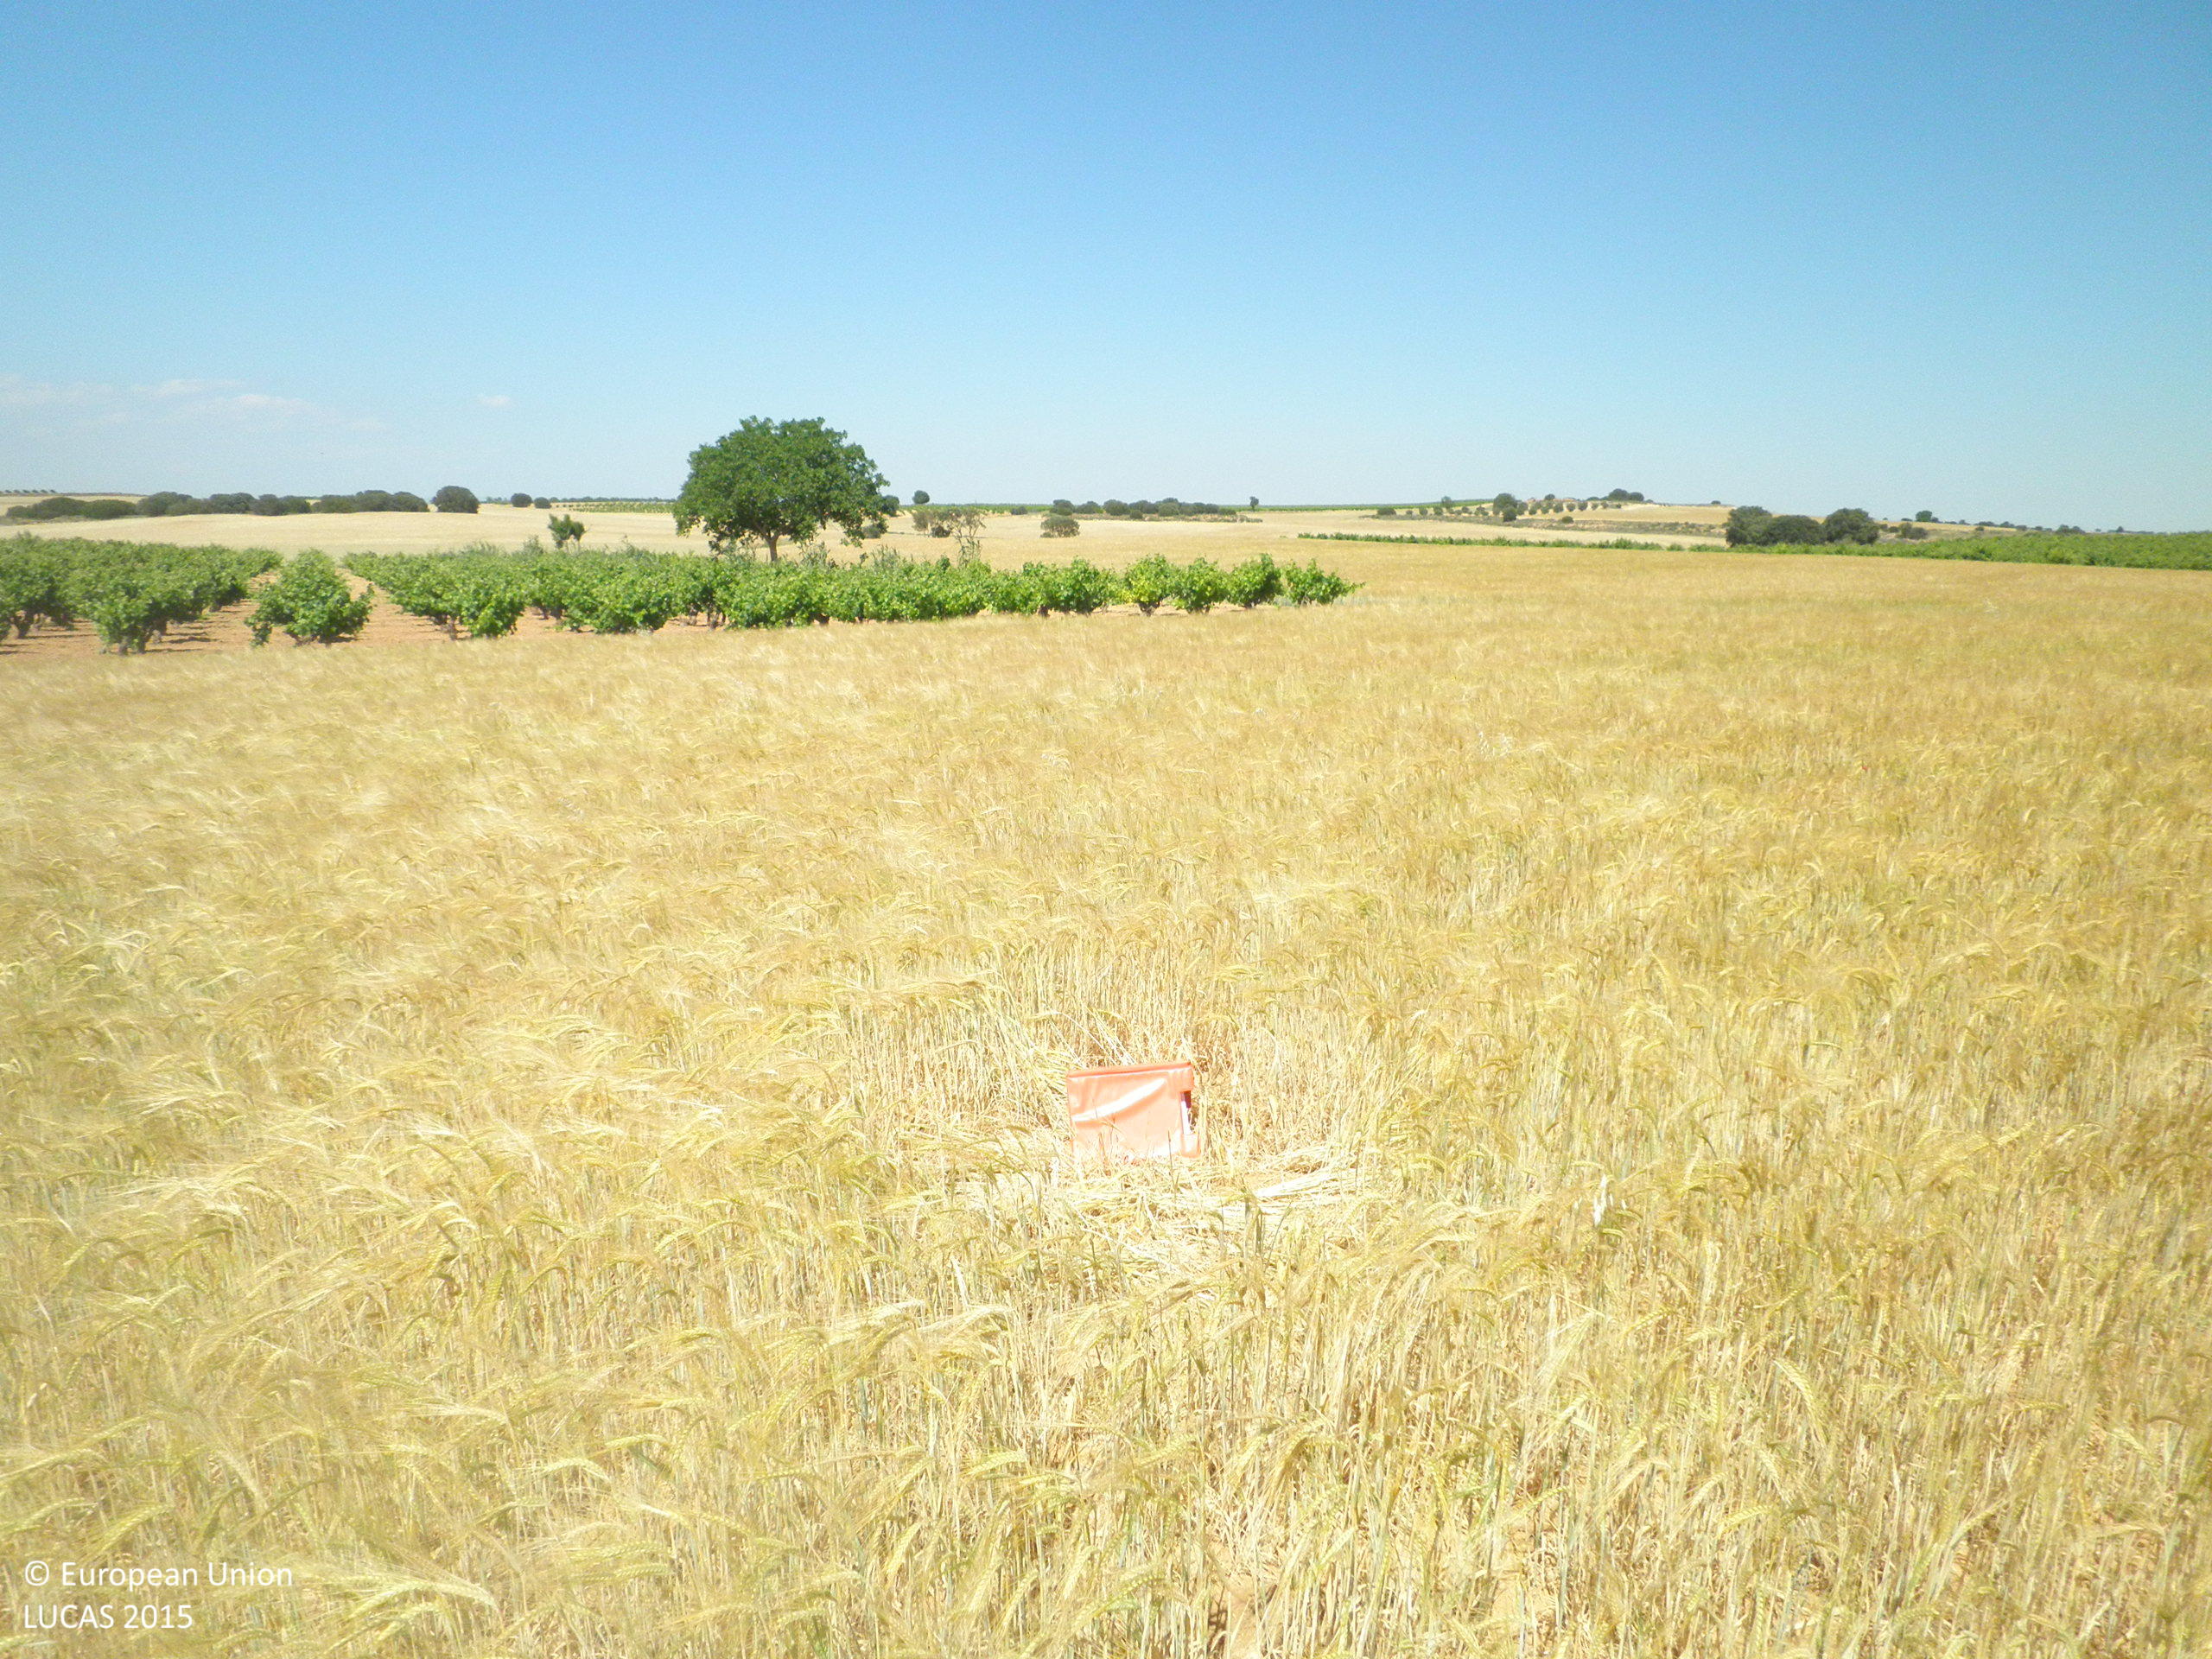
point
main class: Cropland
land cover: Barley
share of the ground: > 75 %
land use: Agriculture (excluding fallow land and kitchen gardens)
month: June
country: ES
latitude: 39.4073
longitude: -1.7928
